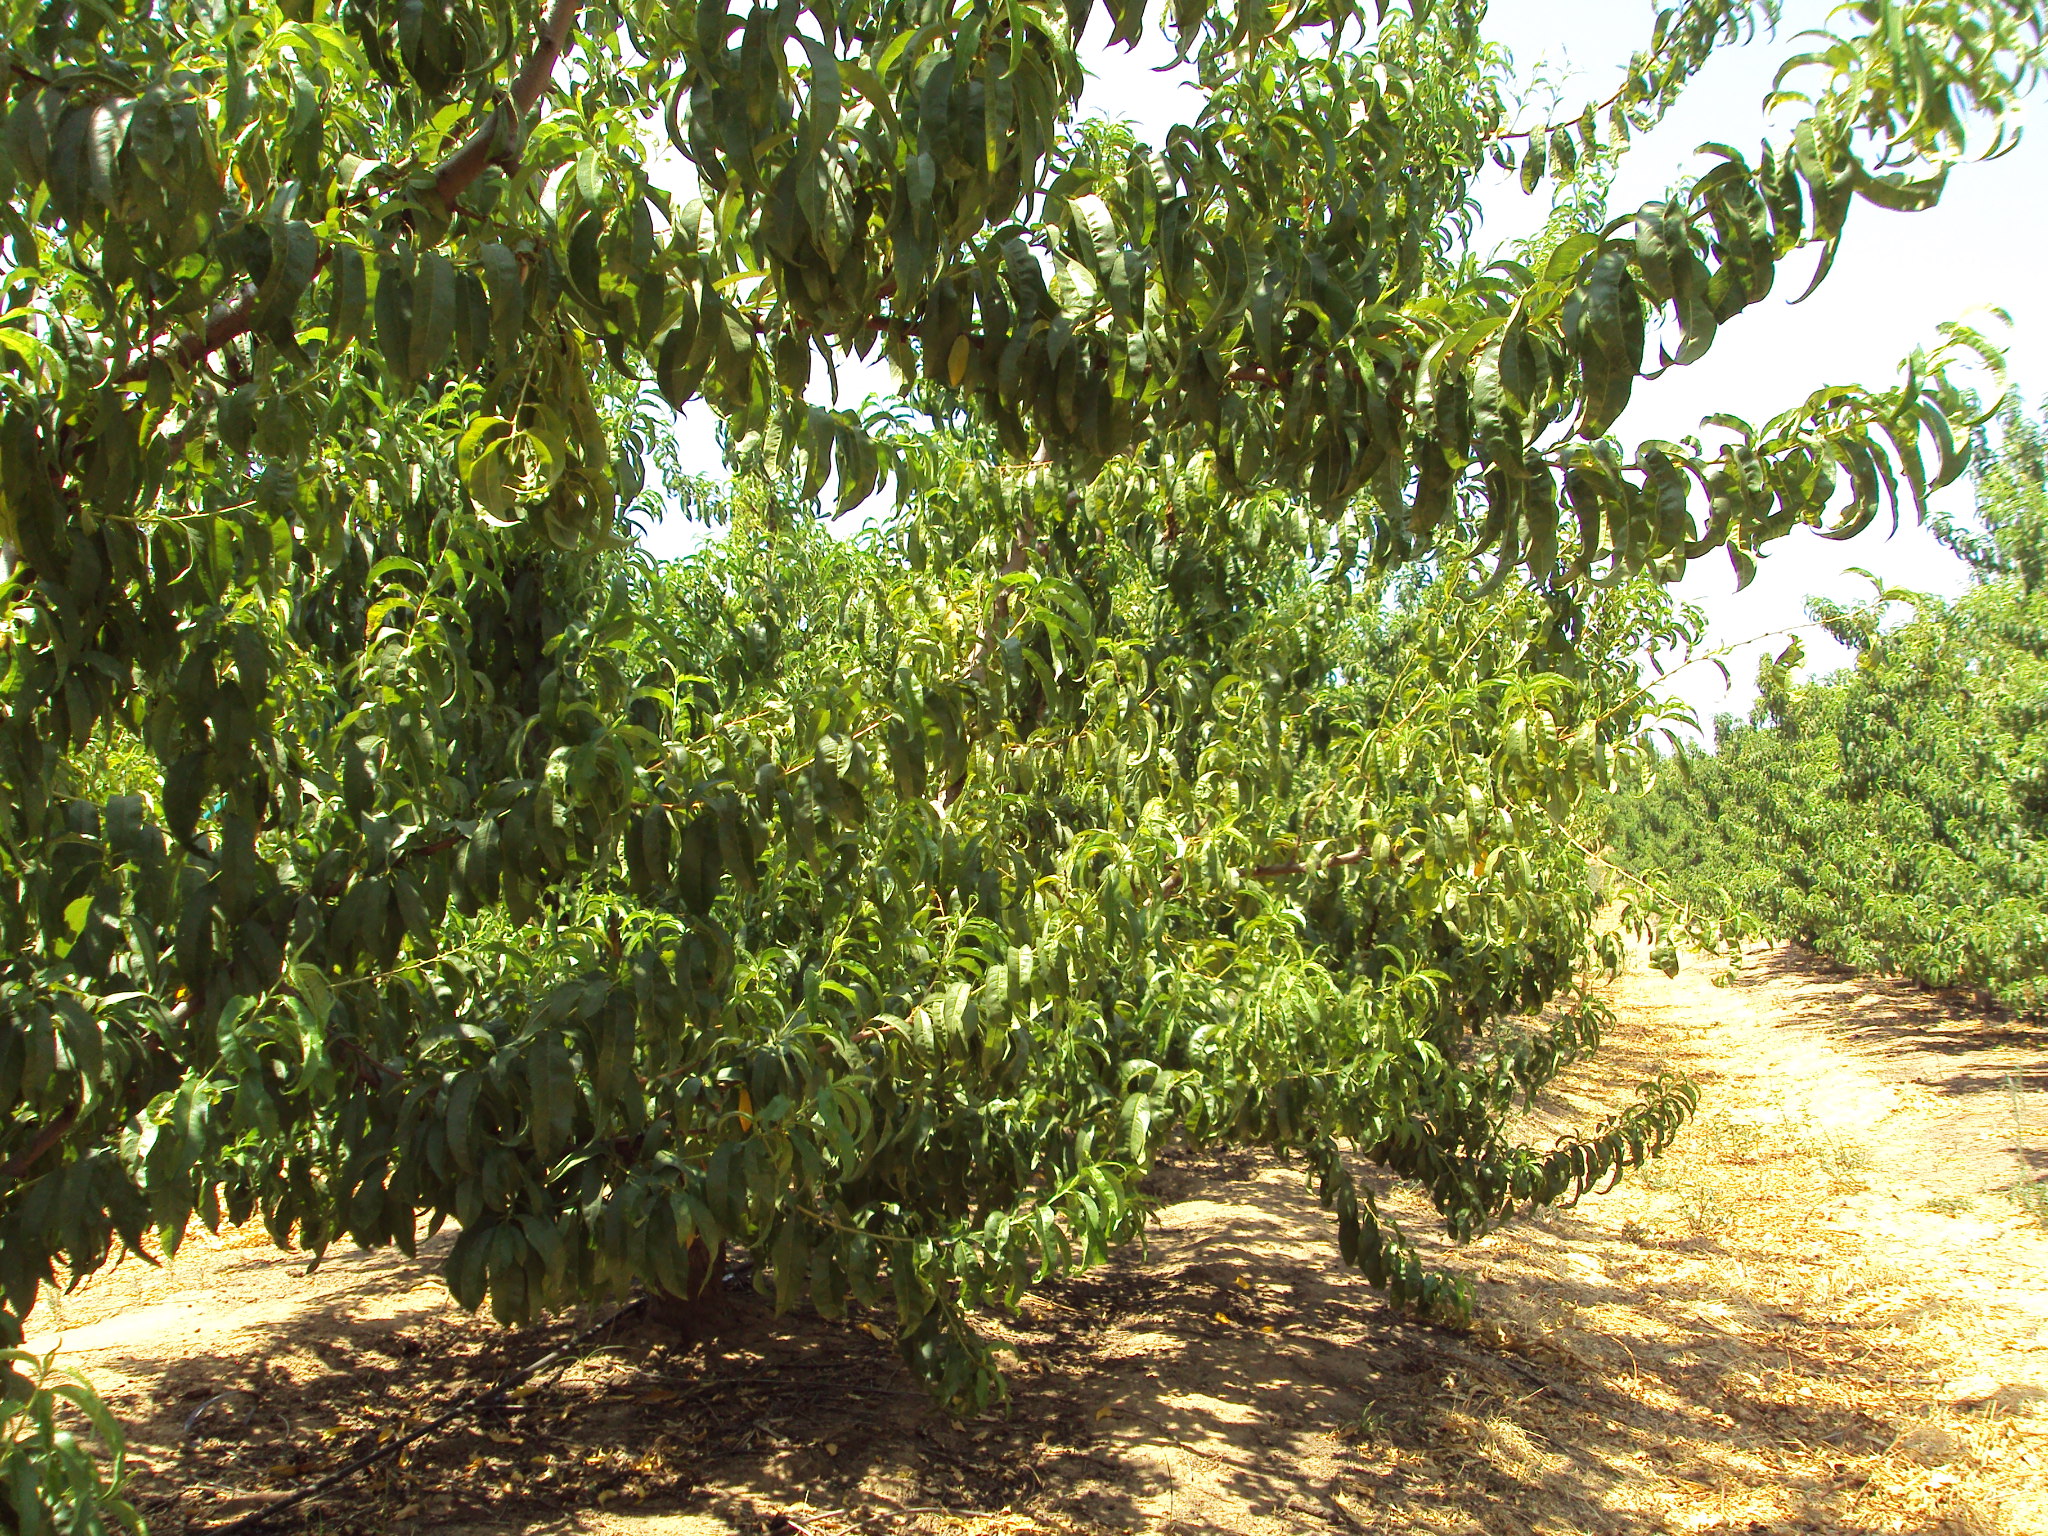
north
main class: Cropland
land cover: Other fruit trees and berries
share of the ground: 50 - 75 %
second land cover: Spontaneously vegetated surfaces
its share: > 75 %
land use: Agriculture (excluding fallow land and kitchen gardens)
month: July
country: ES
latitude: 37.3800
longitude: -7.0392
